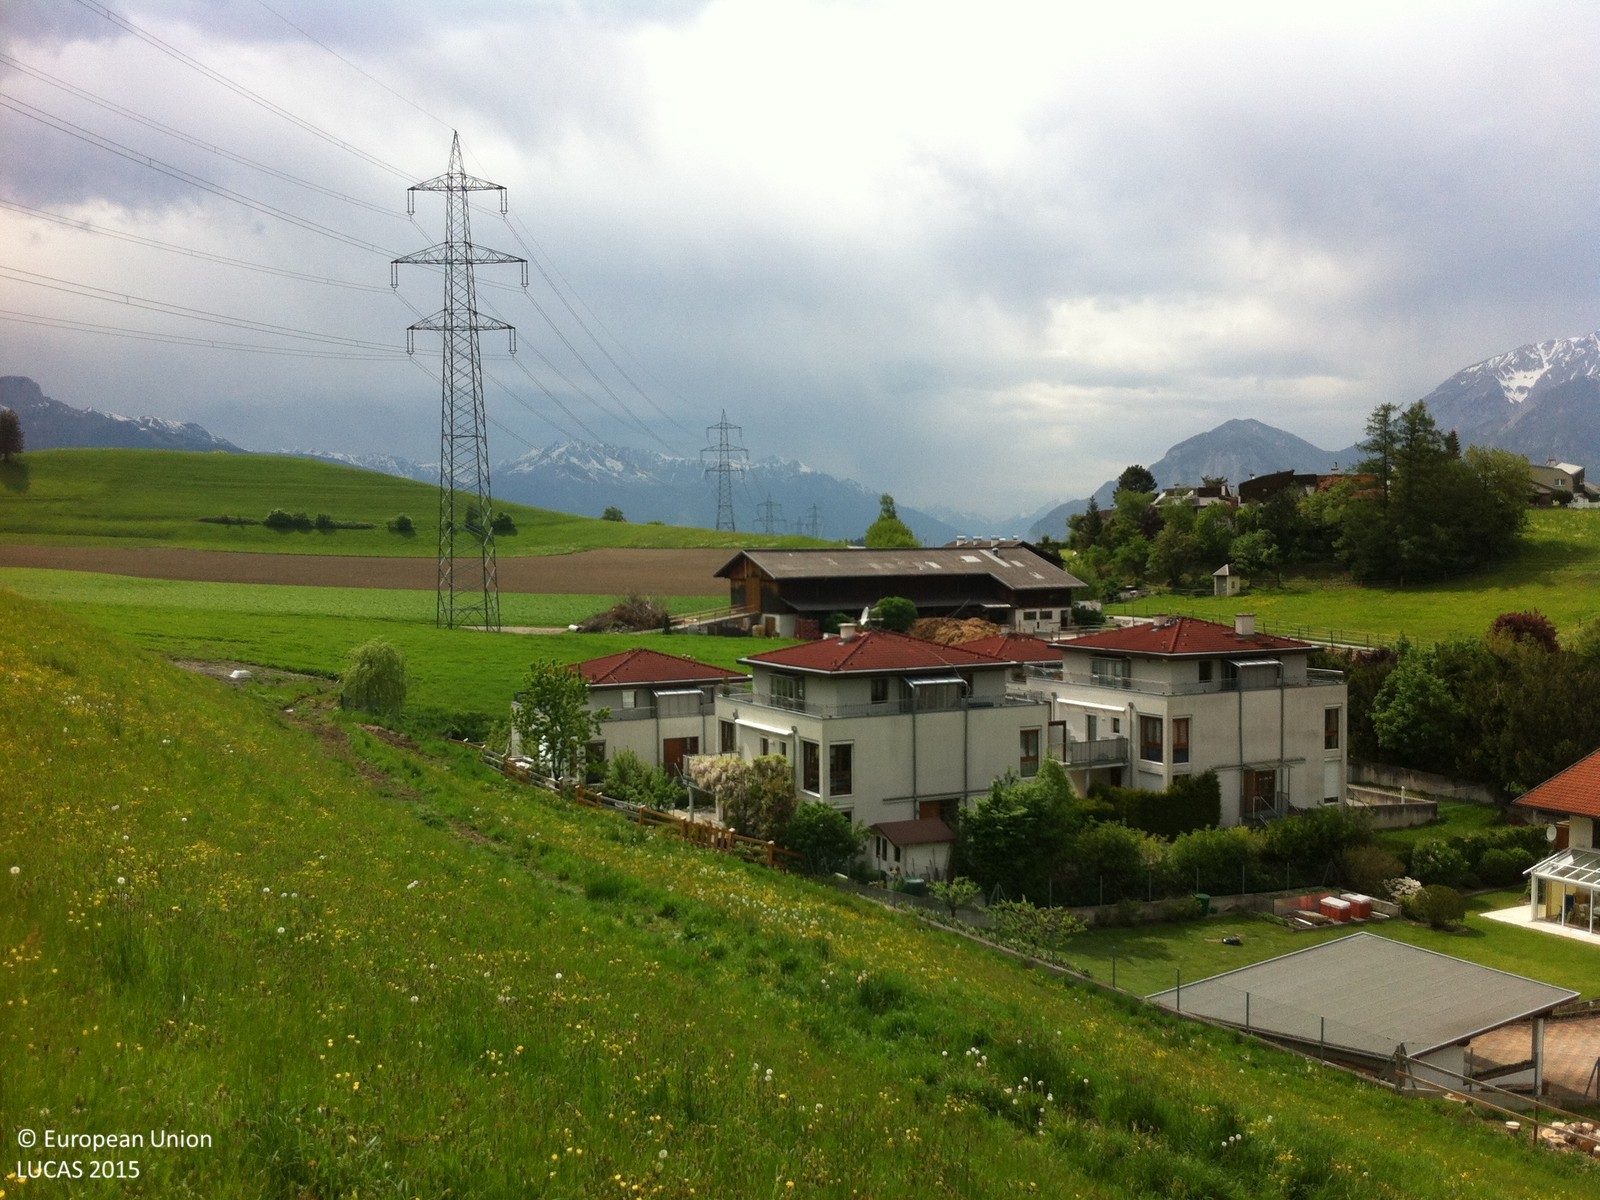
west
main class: Grassland
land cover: Grassland without tree/shrub cover
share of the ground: > 75 %
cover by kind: herbaceous plants 100 %
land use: Agriculture (excluding fallow land and kitchen gardens)
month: May
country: AT
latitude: 47.2417
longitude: 11.4650
